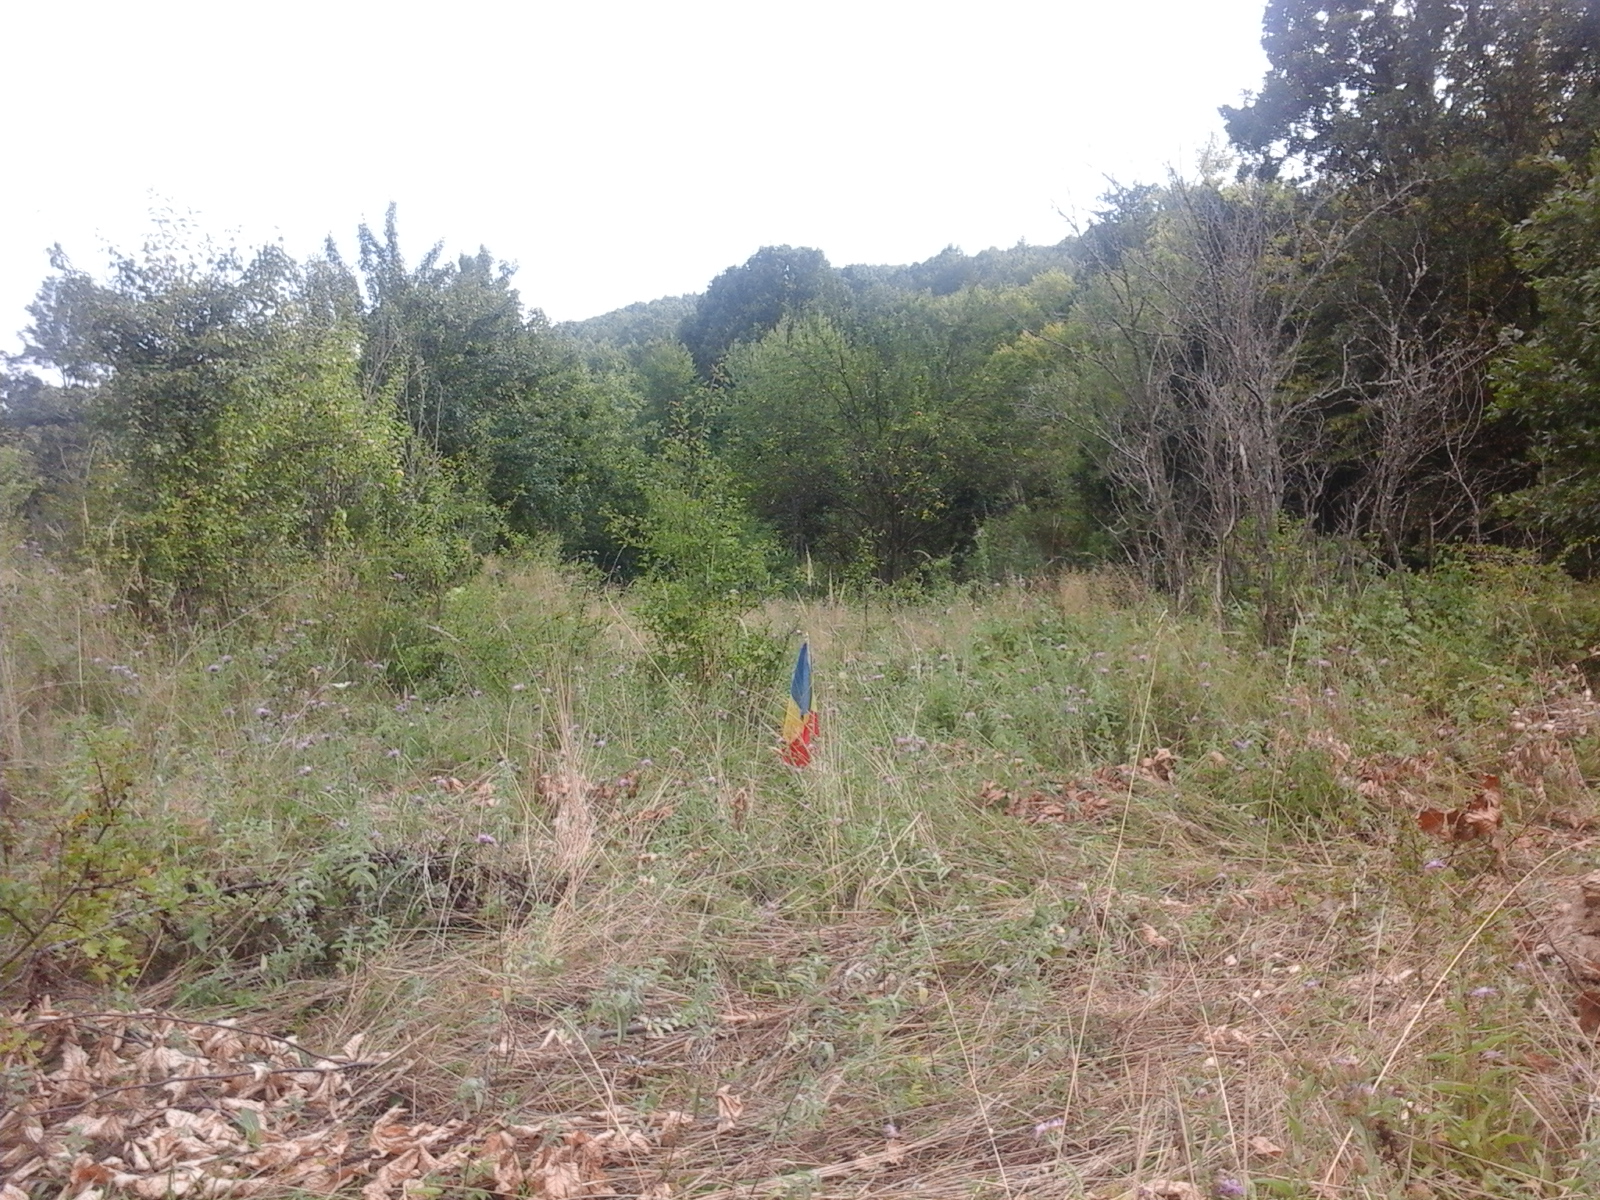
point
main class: Grassland
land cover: Grassland with sparse tree/shrub cover
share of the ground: > 75 %
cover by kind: herbaceous plants 95 %, broadleaved forest trees 5 %
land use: Agriculture (excluding fallow land and kitchen gardens)
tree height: < 5 m
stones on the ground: < 10 %
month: August
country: RO
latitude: 44.8247
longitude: 23.7059
